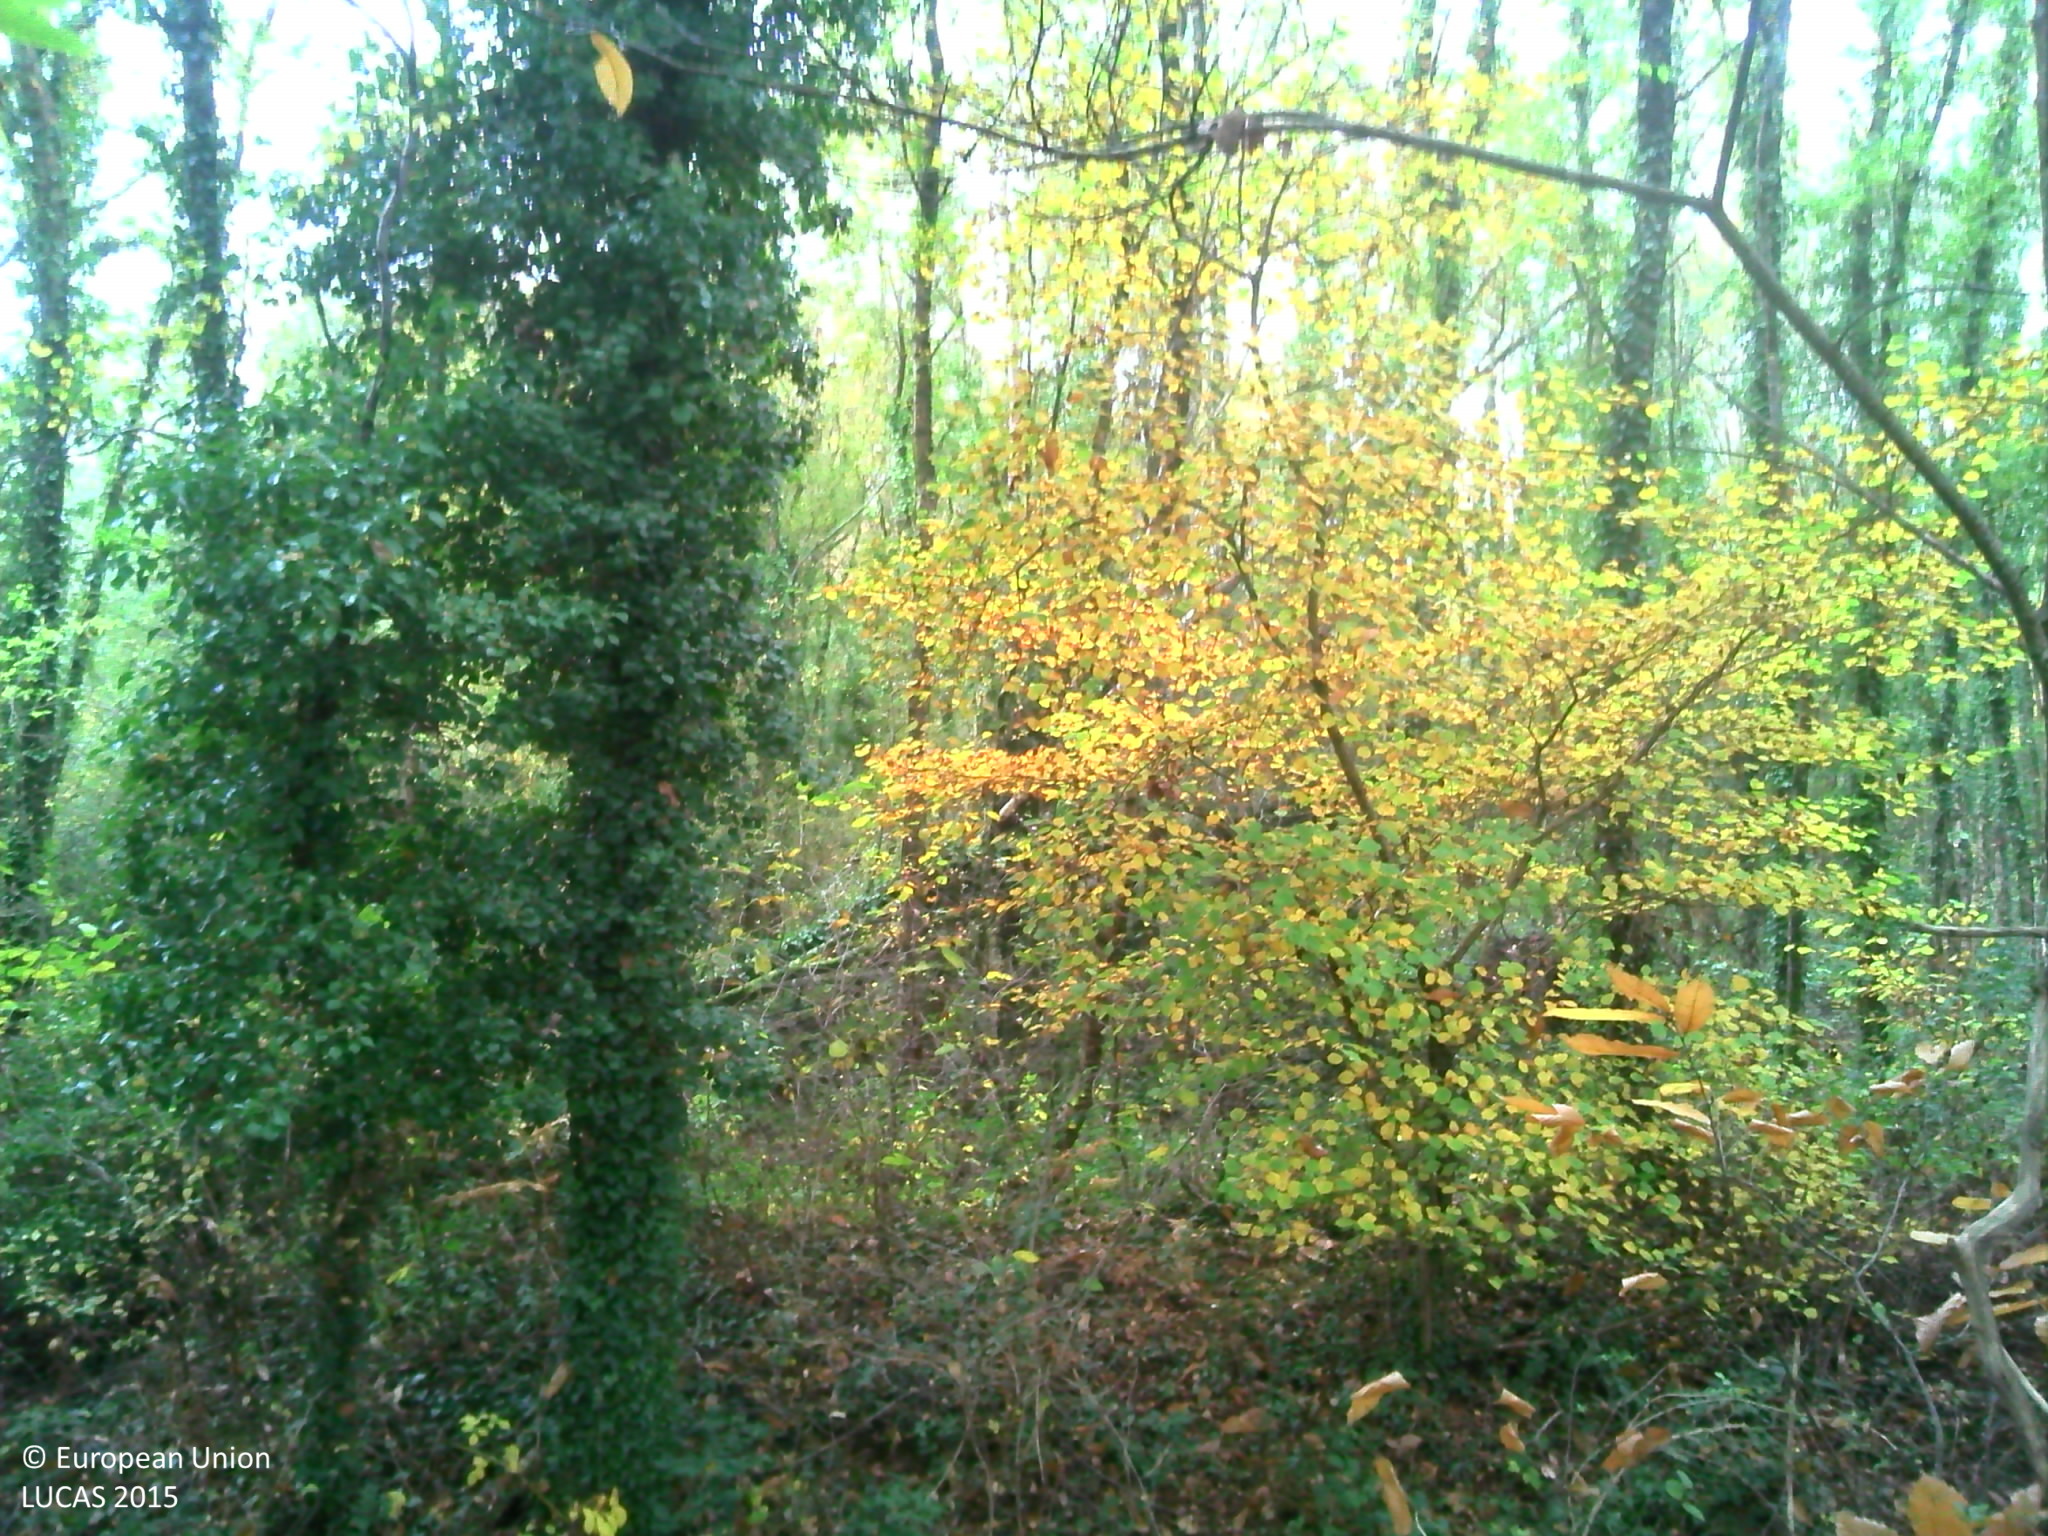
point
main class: Woodland
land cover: Broadleaved woodland
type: acidophilous oak and oak-birch forest
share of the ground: > 75 %
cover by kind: broadleaved forest trees 100 %
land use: Forestry
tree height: > 5 m
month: November
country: FR
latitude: 48.1234
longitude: -3.0059
